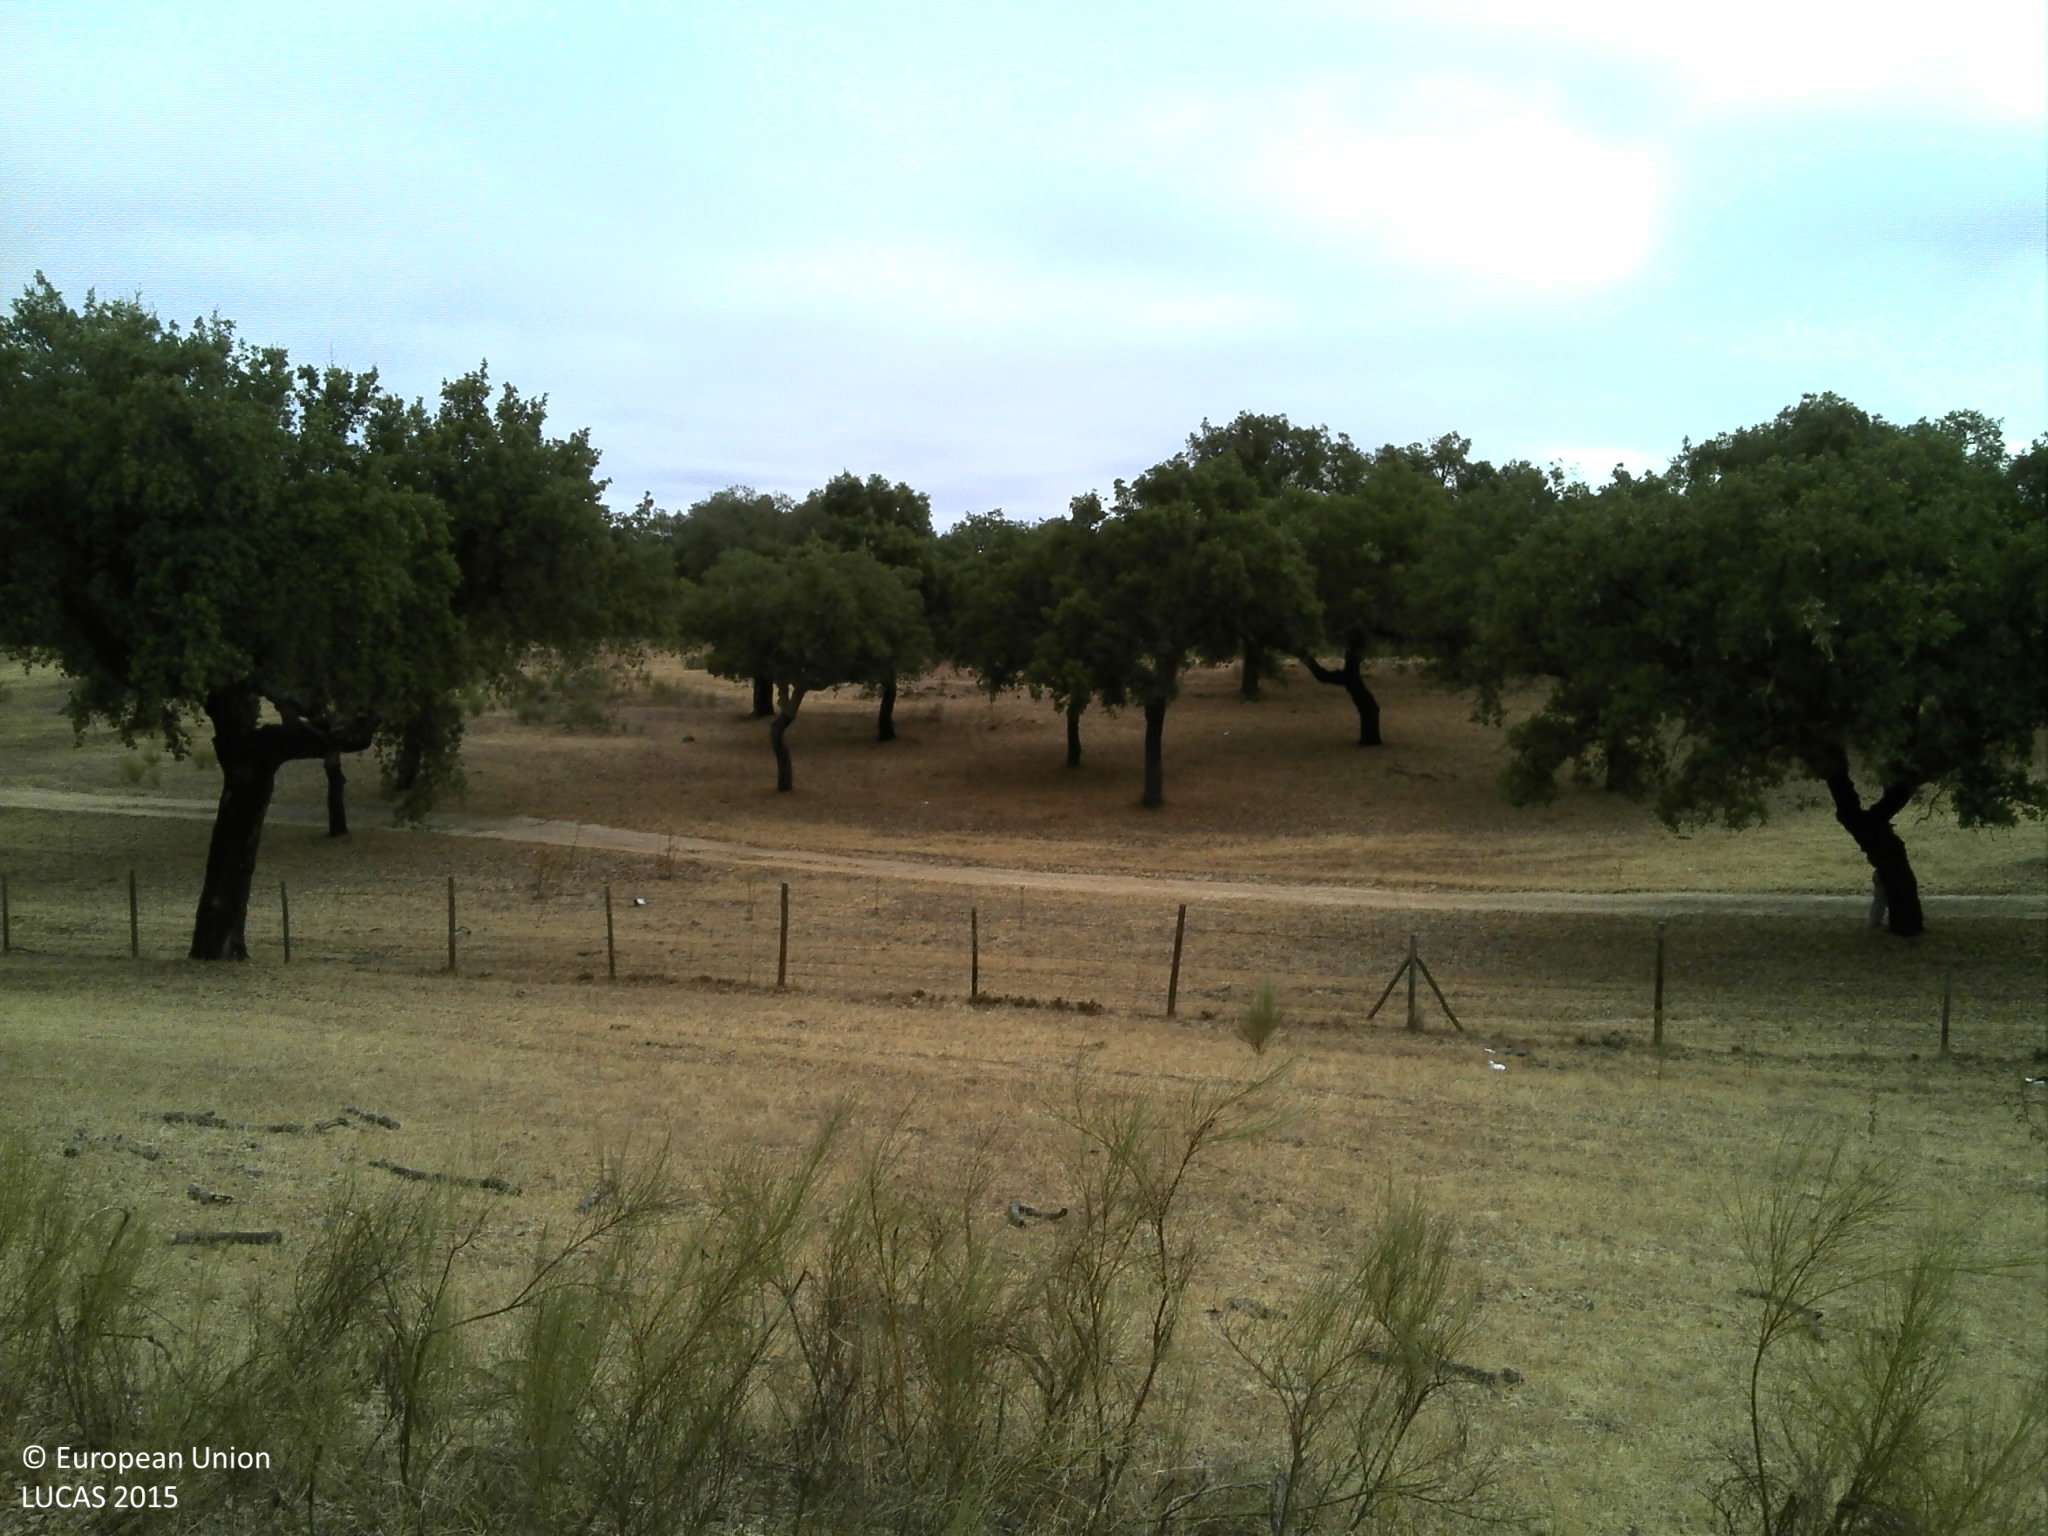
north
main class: Woodland
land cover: Broadleaved woodland
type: broadleaved evergreen forest
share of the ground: 25 - 50 %
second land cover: Grassland without tree/shrub cover
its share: 10 - 25 %
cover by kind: unconsolidated bare surface 60 %, broadleaved forest trees 30 %, herbaceous plants 10 %
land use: Forestry
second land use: Agriculture (excluding fallow land and kitchen gardens)
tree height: > 5 m
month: July
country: PT
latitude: 39.2251
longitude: -7.4507
